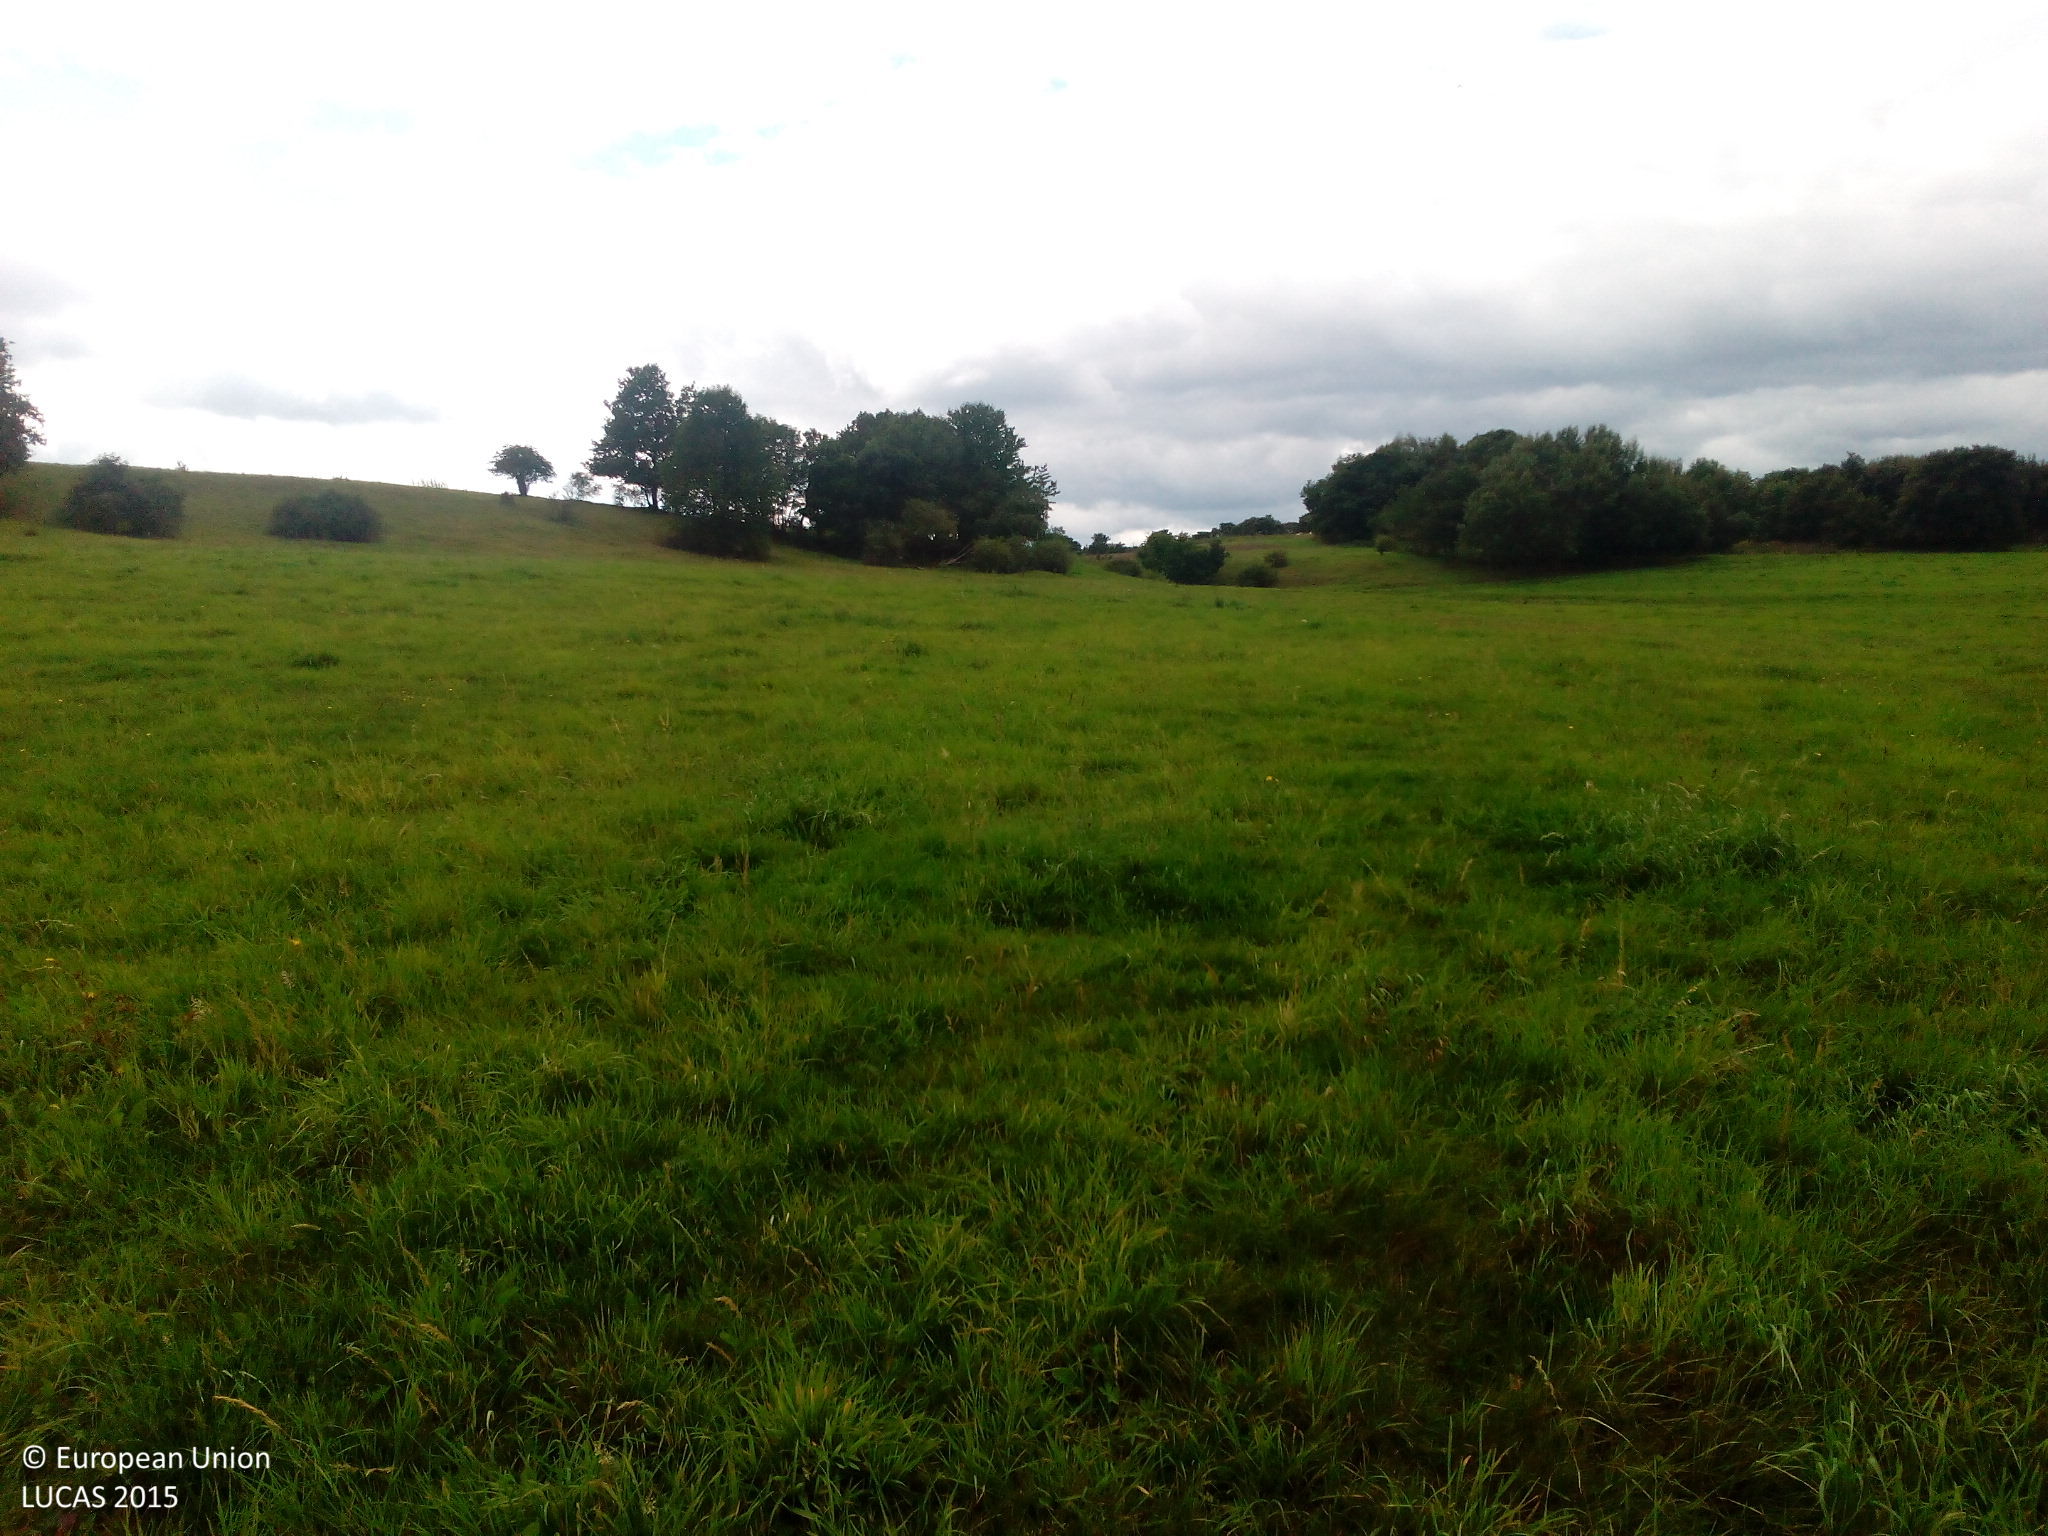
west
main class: Grassland
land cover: Grassland without tree/shrub cover
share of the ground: > 75 %
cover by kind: herbaceous plants 100 %
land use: Agriculture (excluding fallow land and kitchen gardens)
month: September
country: DE
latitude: 51.6188
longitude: 10.9385
